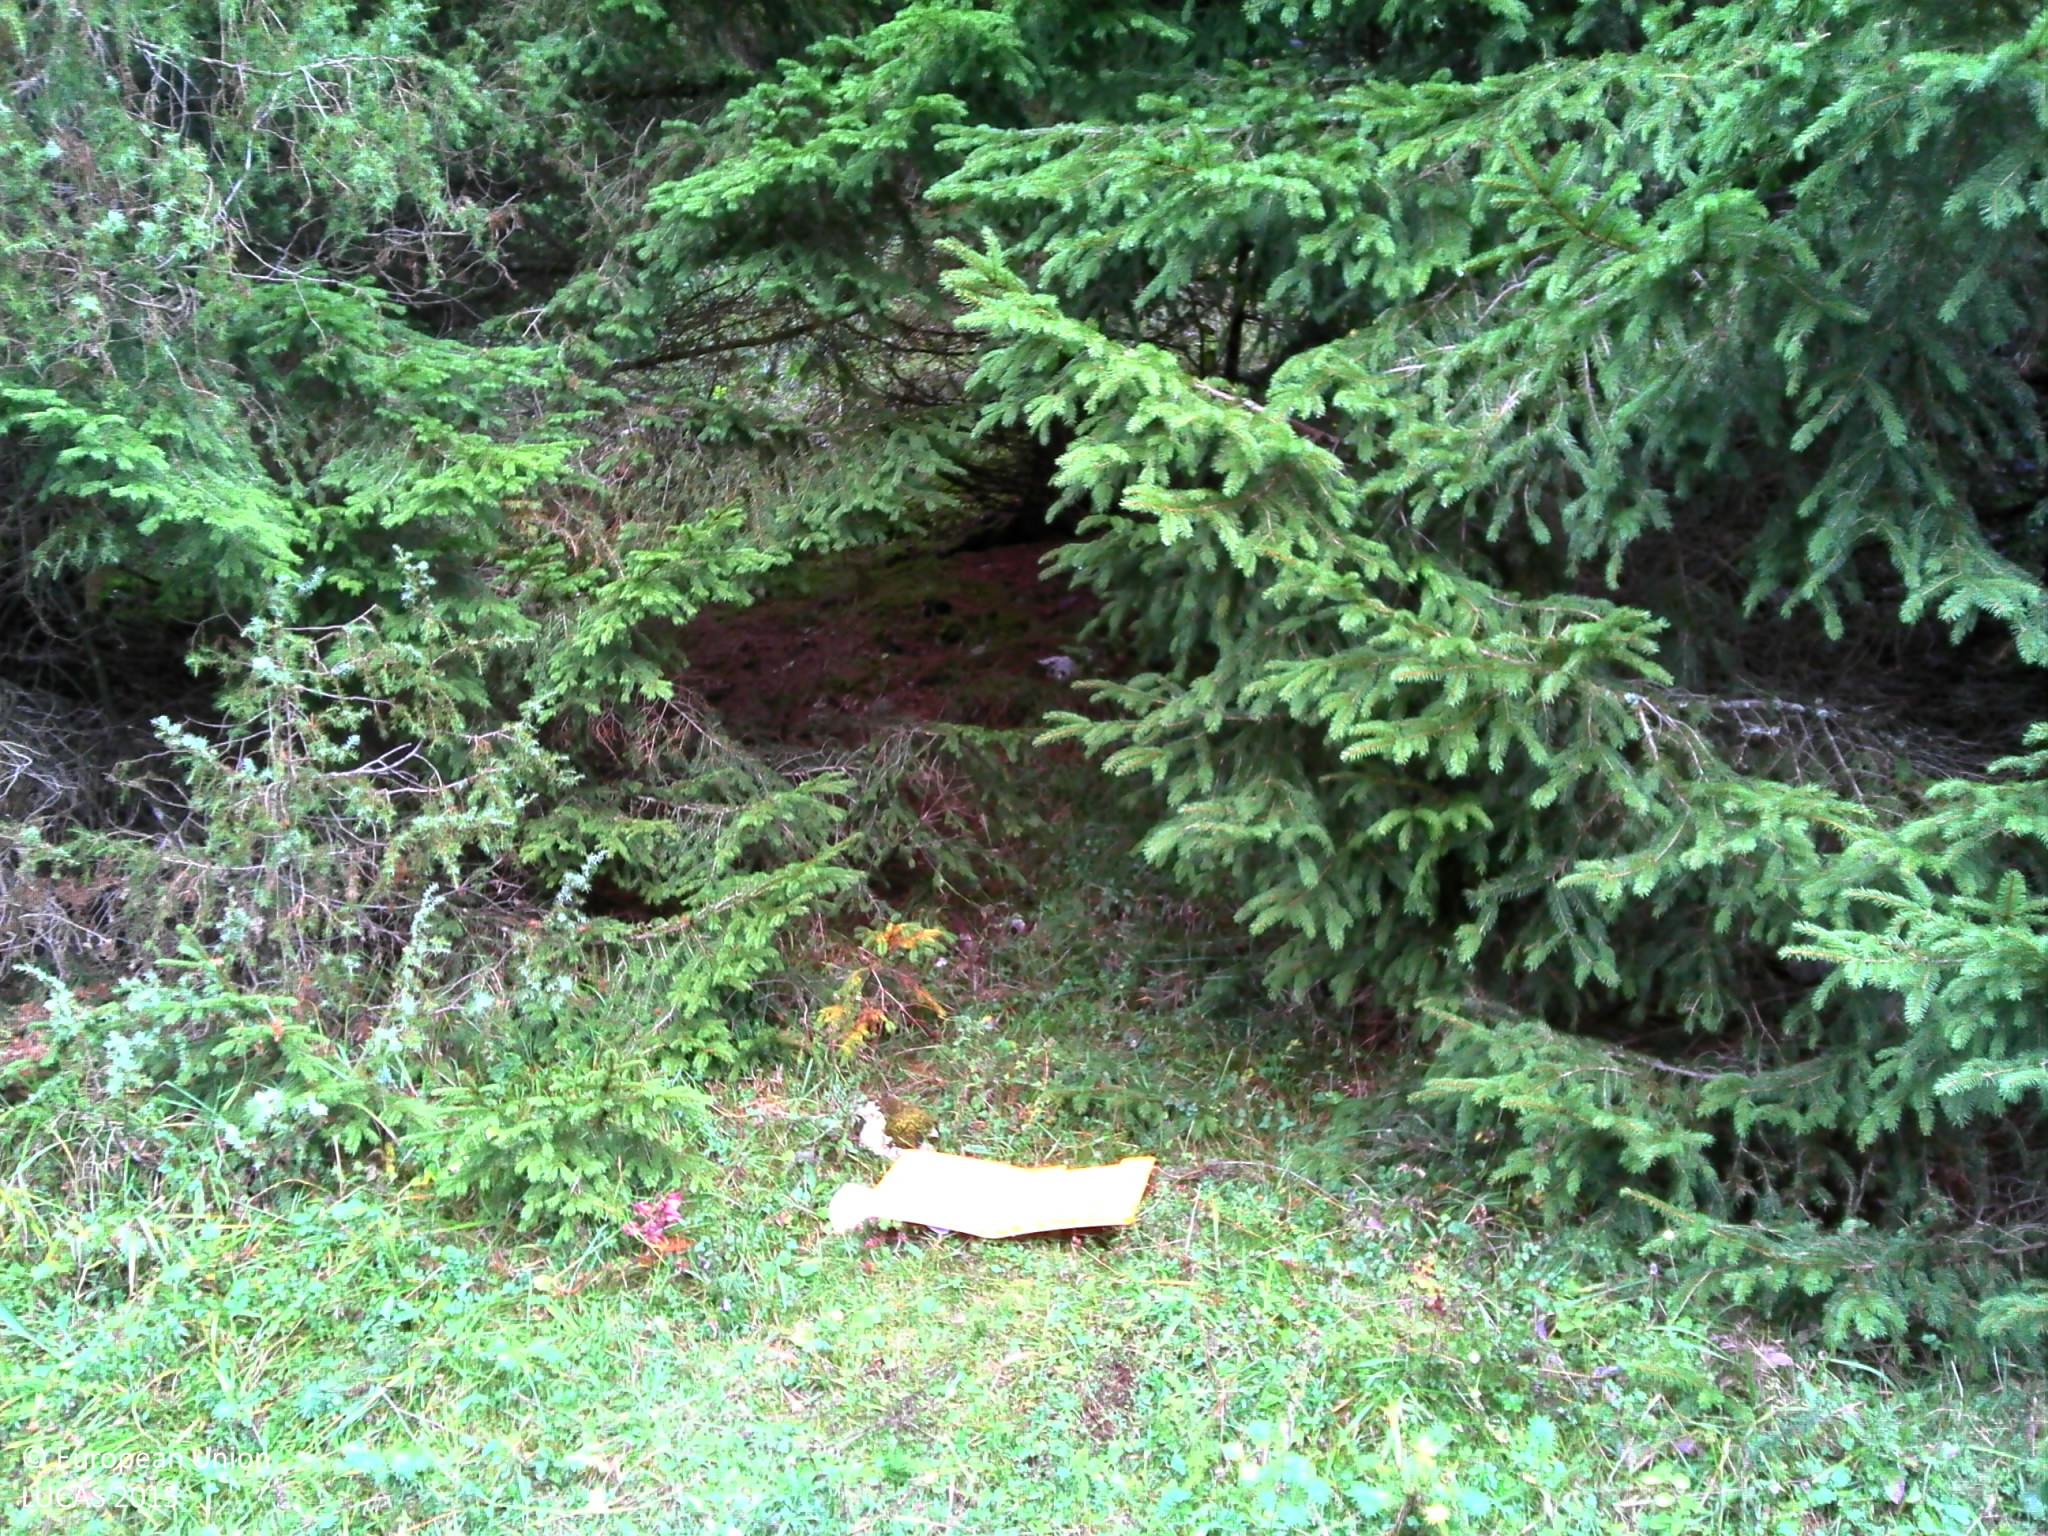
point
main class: Woodland
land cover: Spruce dominated coniferous woodland
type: alpine coniferous forest
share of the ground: > 75 %
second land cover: Grassland without tree/shrub cover
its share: 10 - 25 %
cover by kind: coniferous forest trees 75 %, herbaceous plants 25 %
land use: Forestry
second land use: Agriculture (excluding fallow land and kitchen gardens)
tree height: > 5 m
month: October
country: FR
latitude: 46.8665
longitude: 6.3686
